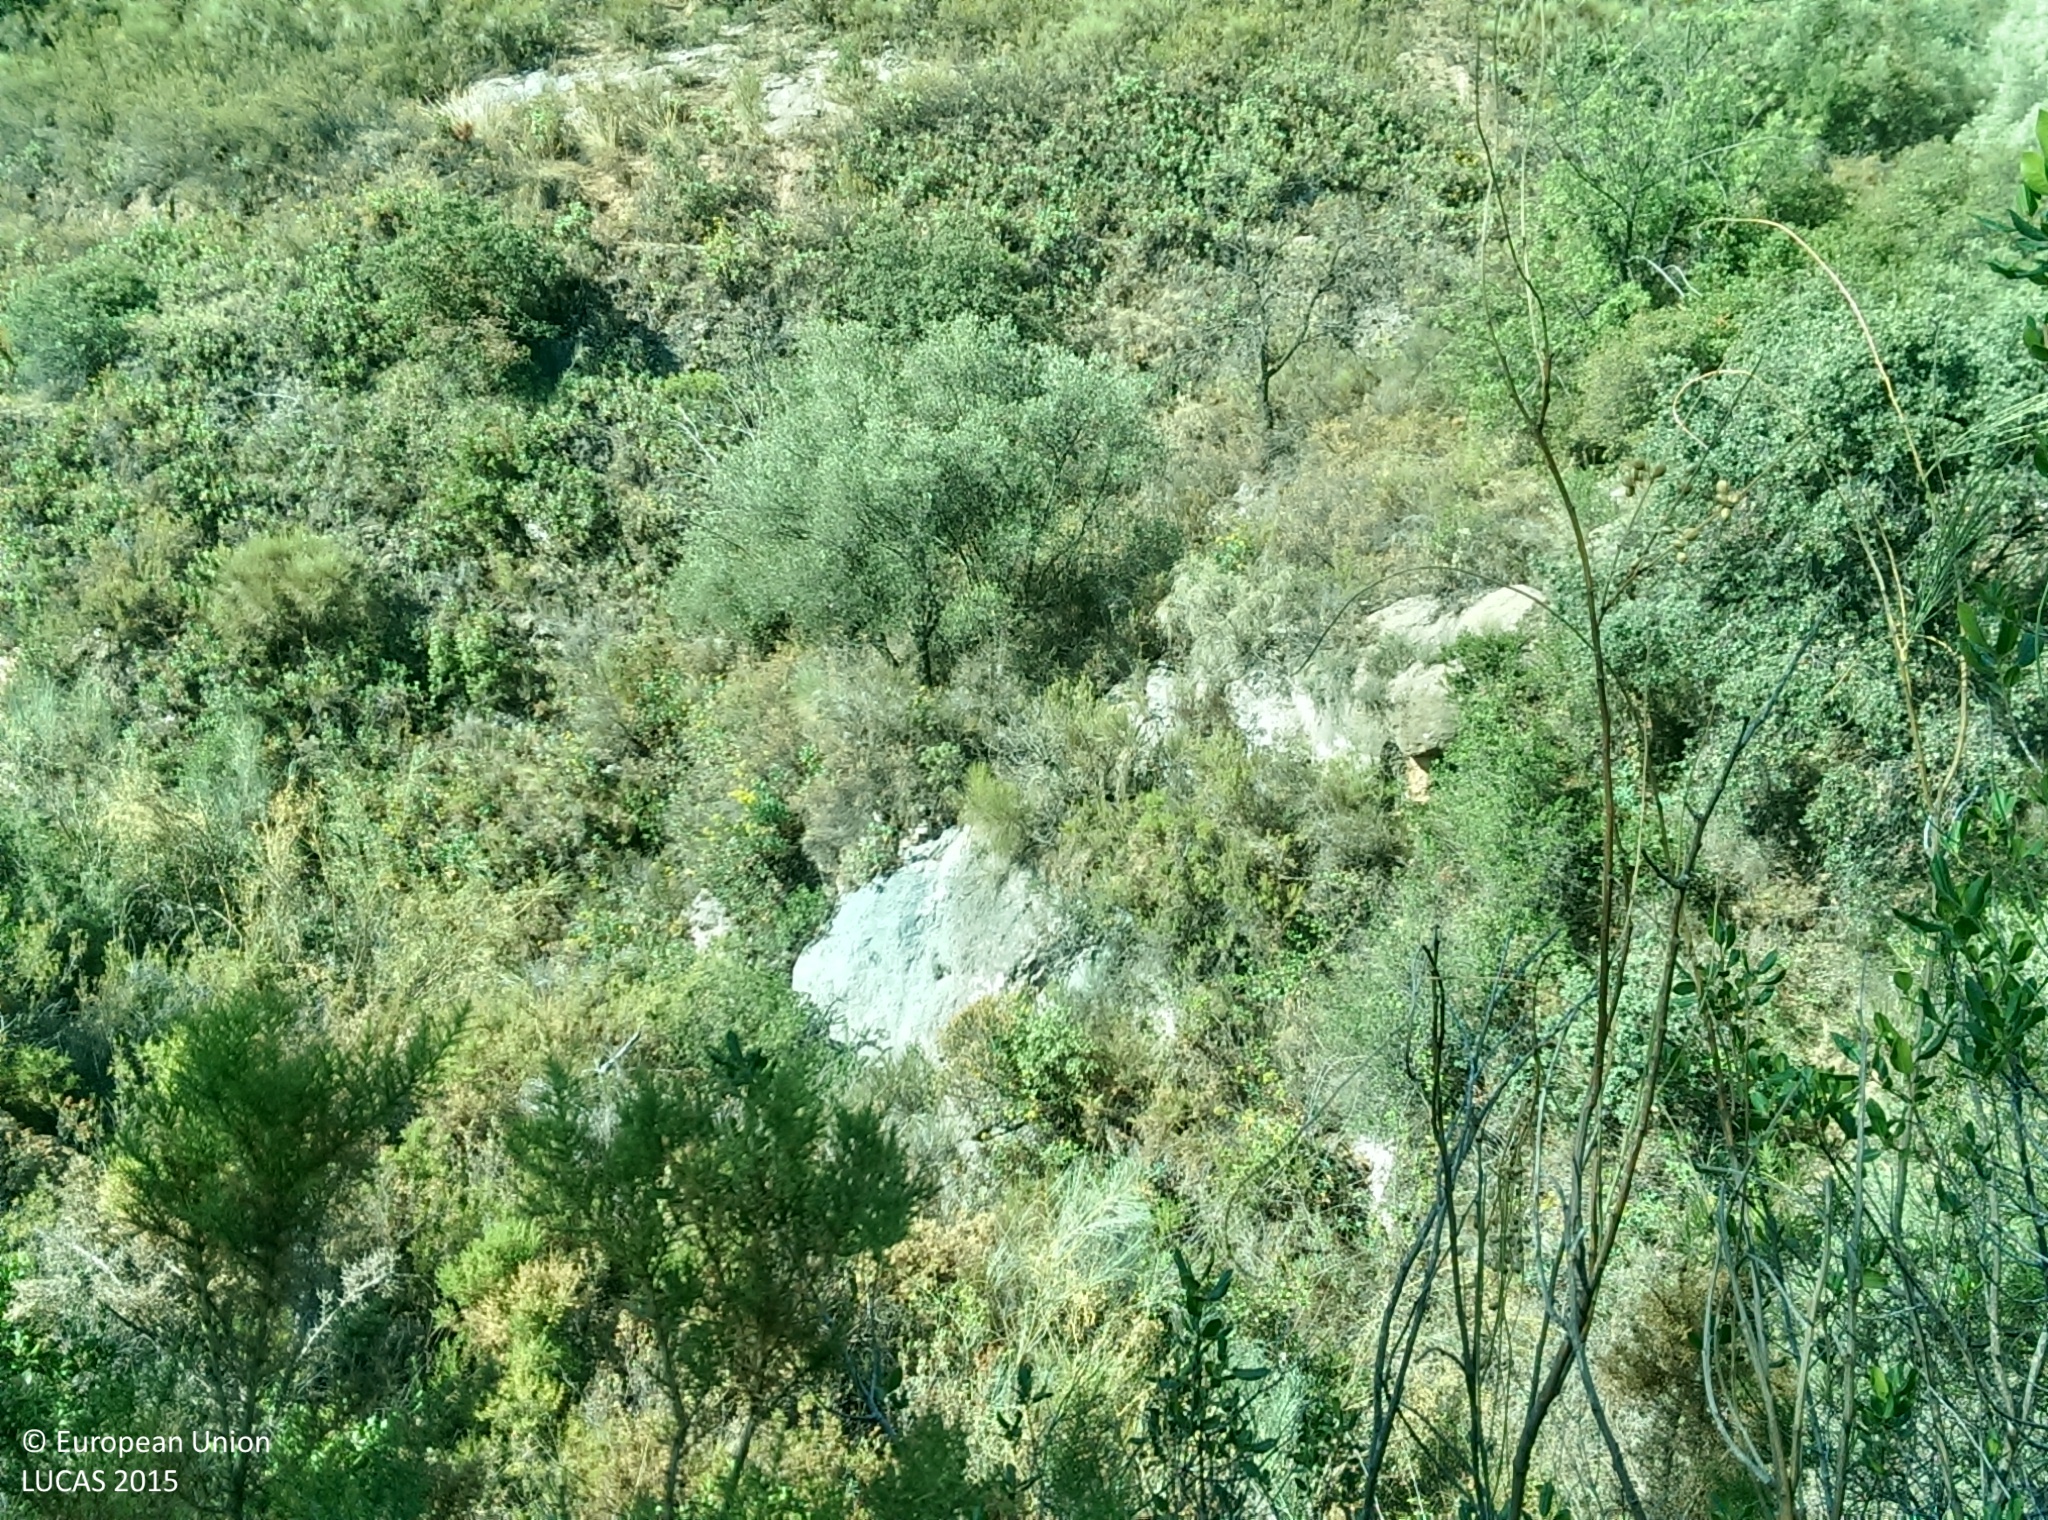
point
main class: Shrubland
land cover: Shrubland with sparse tree cover
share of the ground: > 75 %
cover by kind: shrubs 90 %, broadleaved forest trees 5 %, herbaceous plants 5 %
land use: Semi-natural and natural areas not in use
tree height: > 5 m
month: August
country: ES
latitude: 36.8388
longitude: -3.0879
